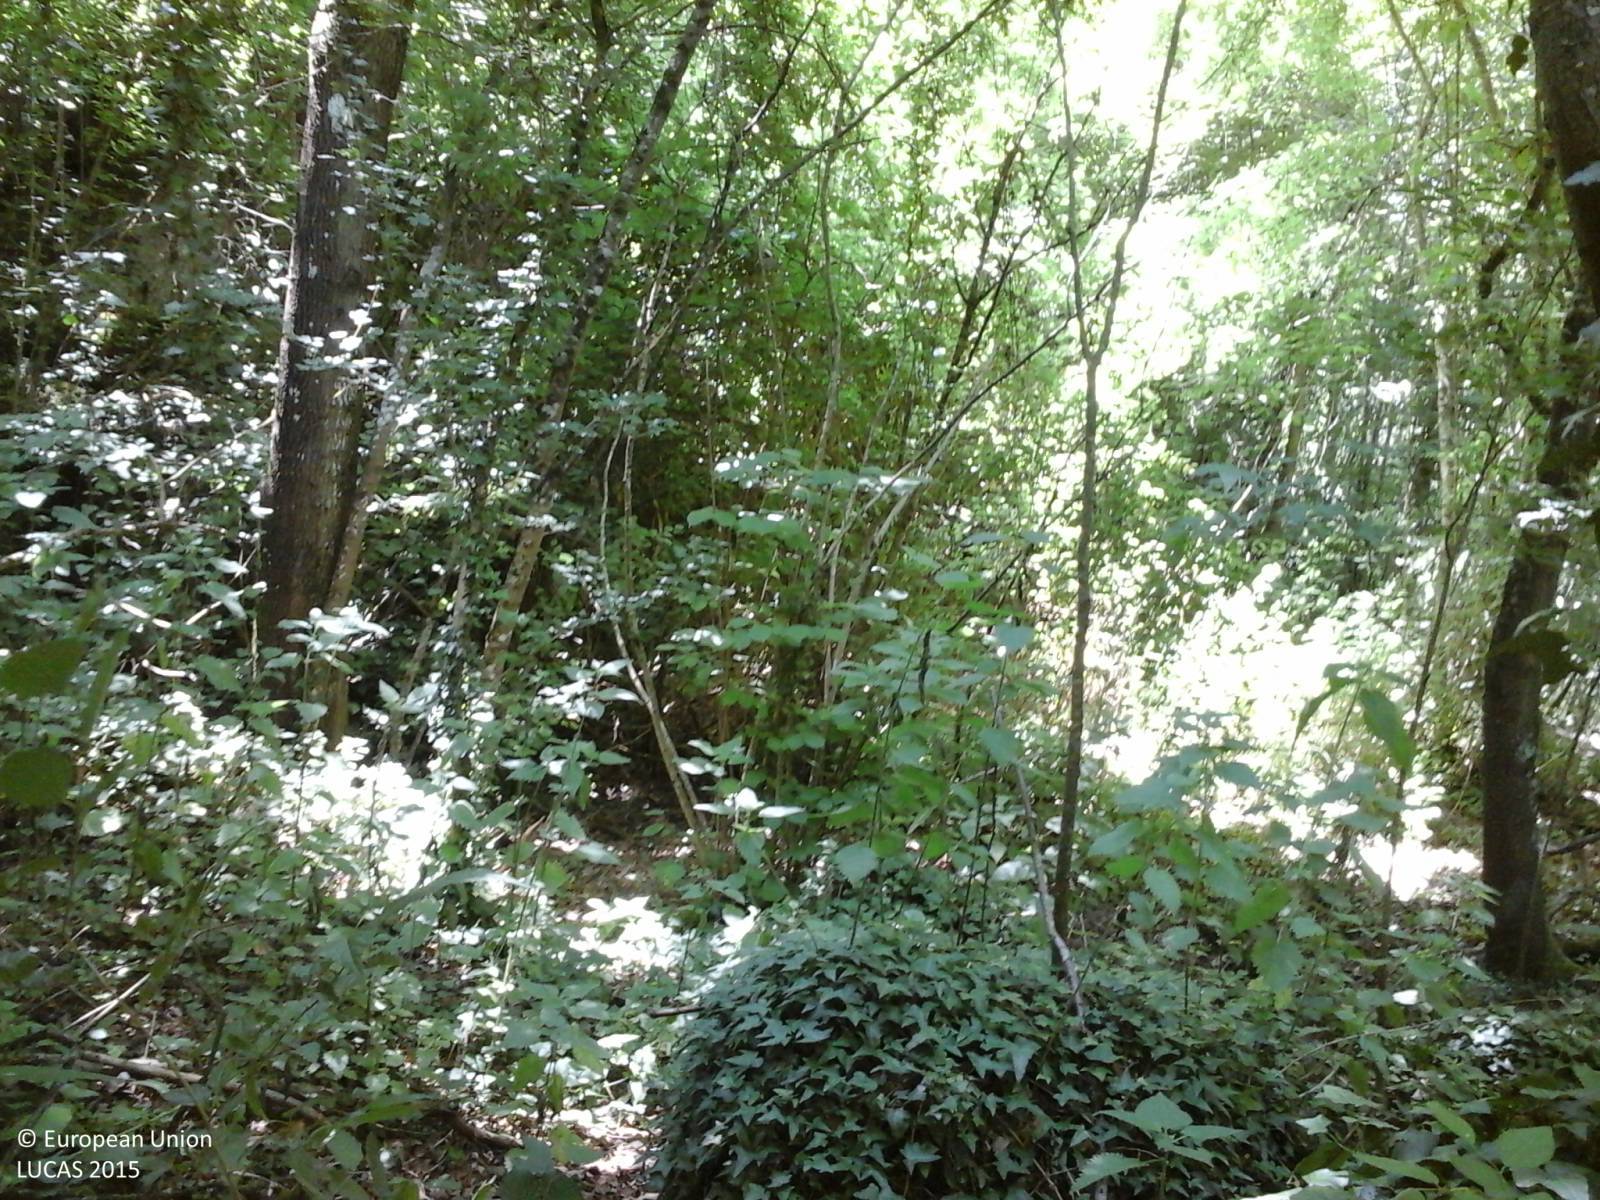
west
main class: Woodland
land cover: Broadleaved woodland
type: thermophilous deciduous forest
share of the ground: > 75 %
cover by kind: broadleaved forest trees 90 %, shrubs 10 %
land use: Forestry
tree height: > 5 m
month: June
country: IT
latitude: 42.5027
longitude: 12.2438
